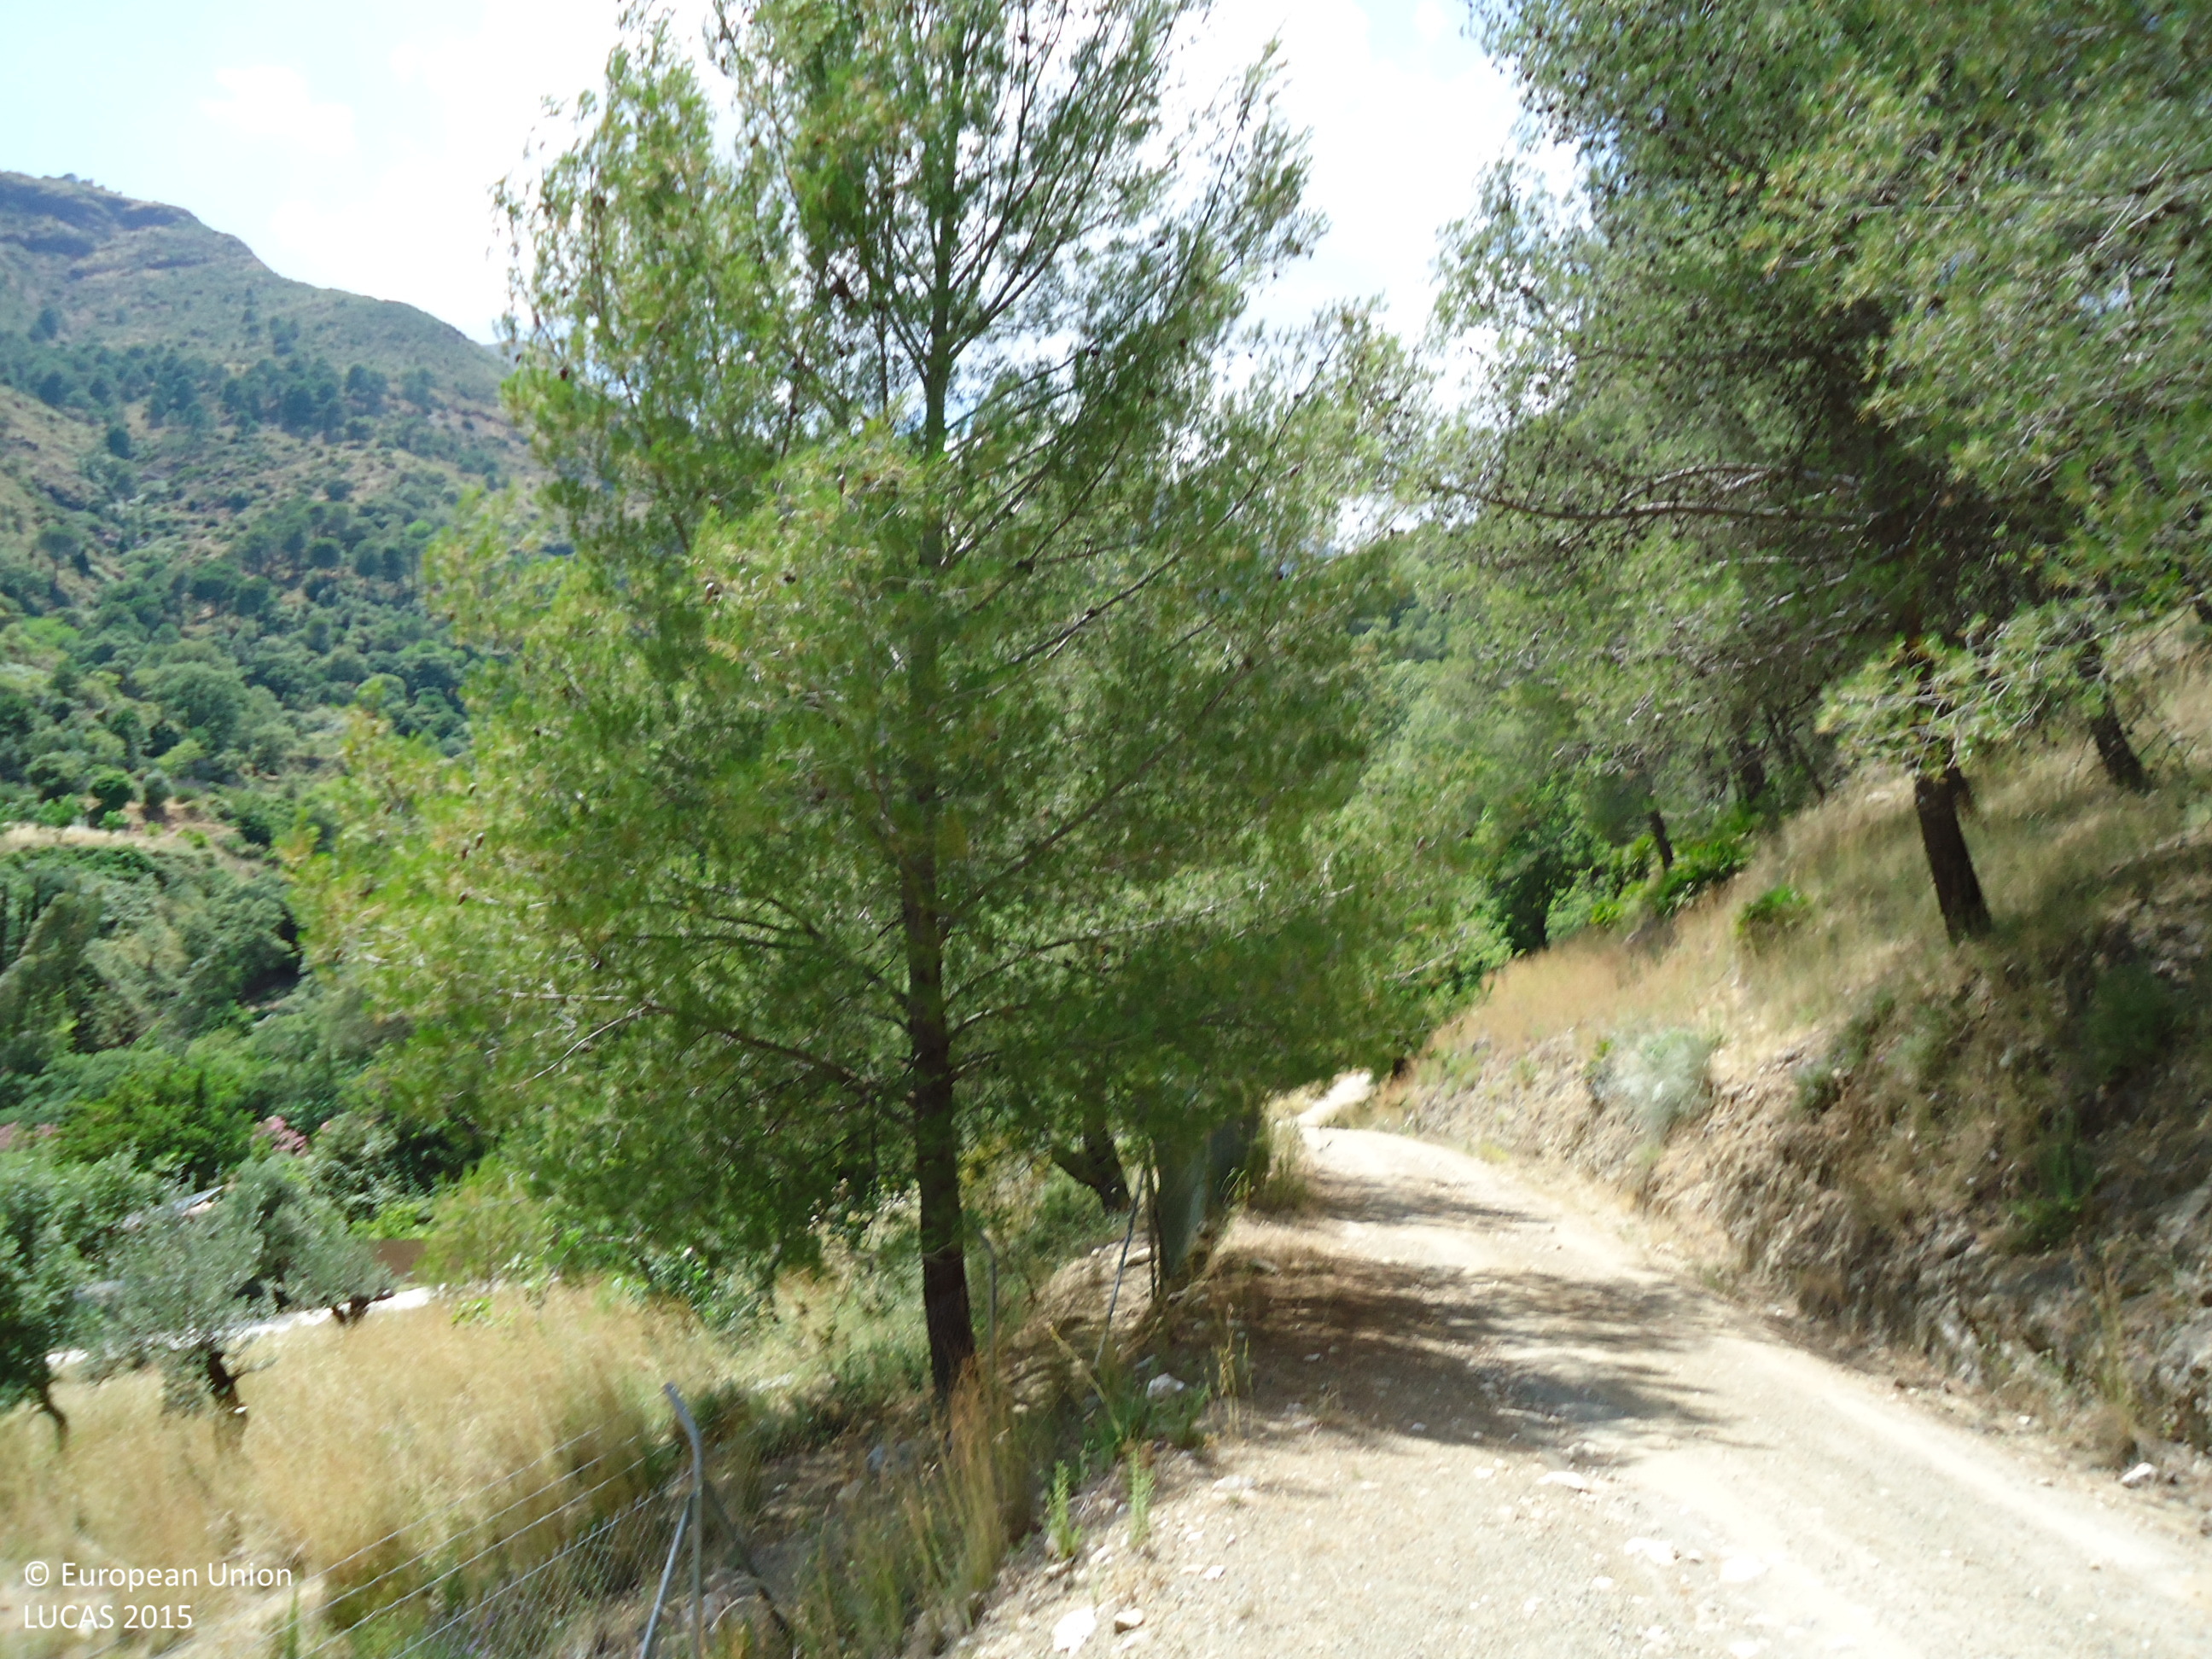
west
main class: Cropland
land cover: Olive groves
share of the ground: 10 - 25 %
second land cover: Spontaneously vegetated surfaces
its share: > 75 %
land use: Agriculture (excluding fallow land and kitchen gardens)
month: June
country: ES
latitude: 36.6896
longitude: -4.9362
